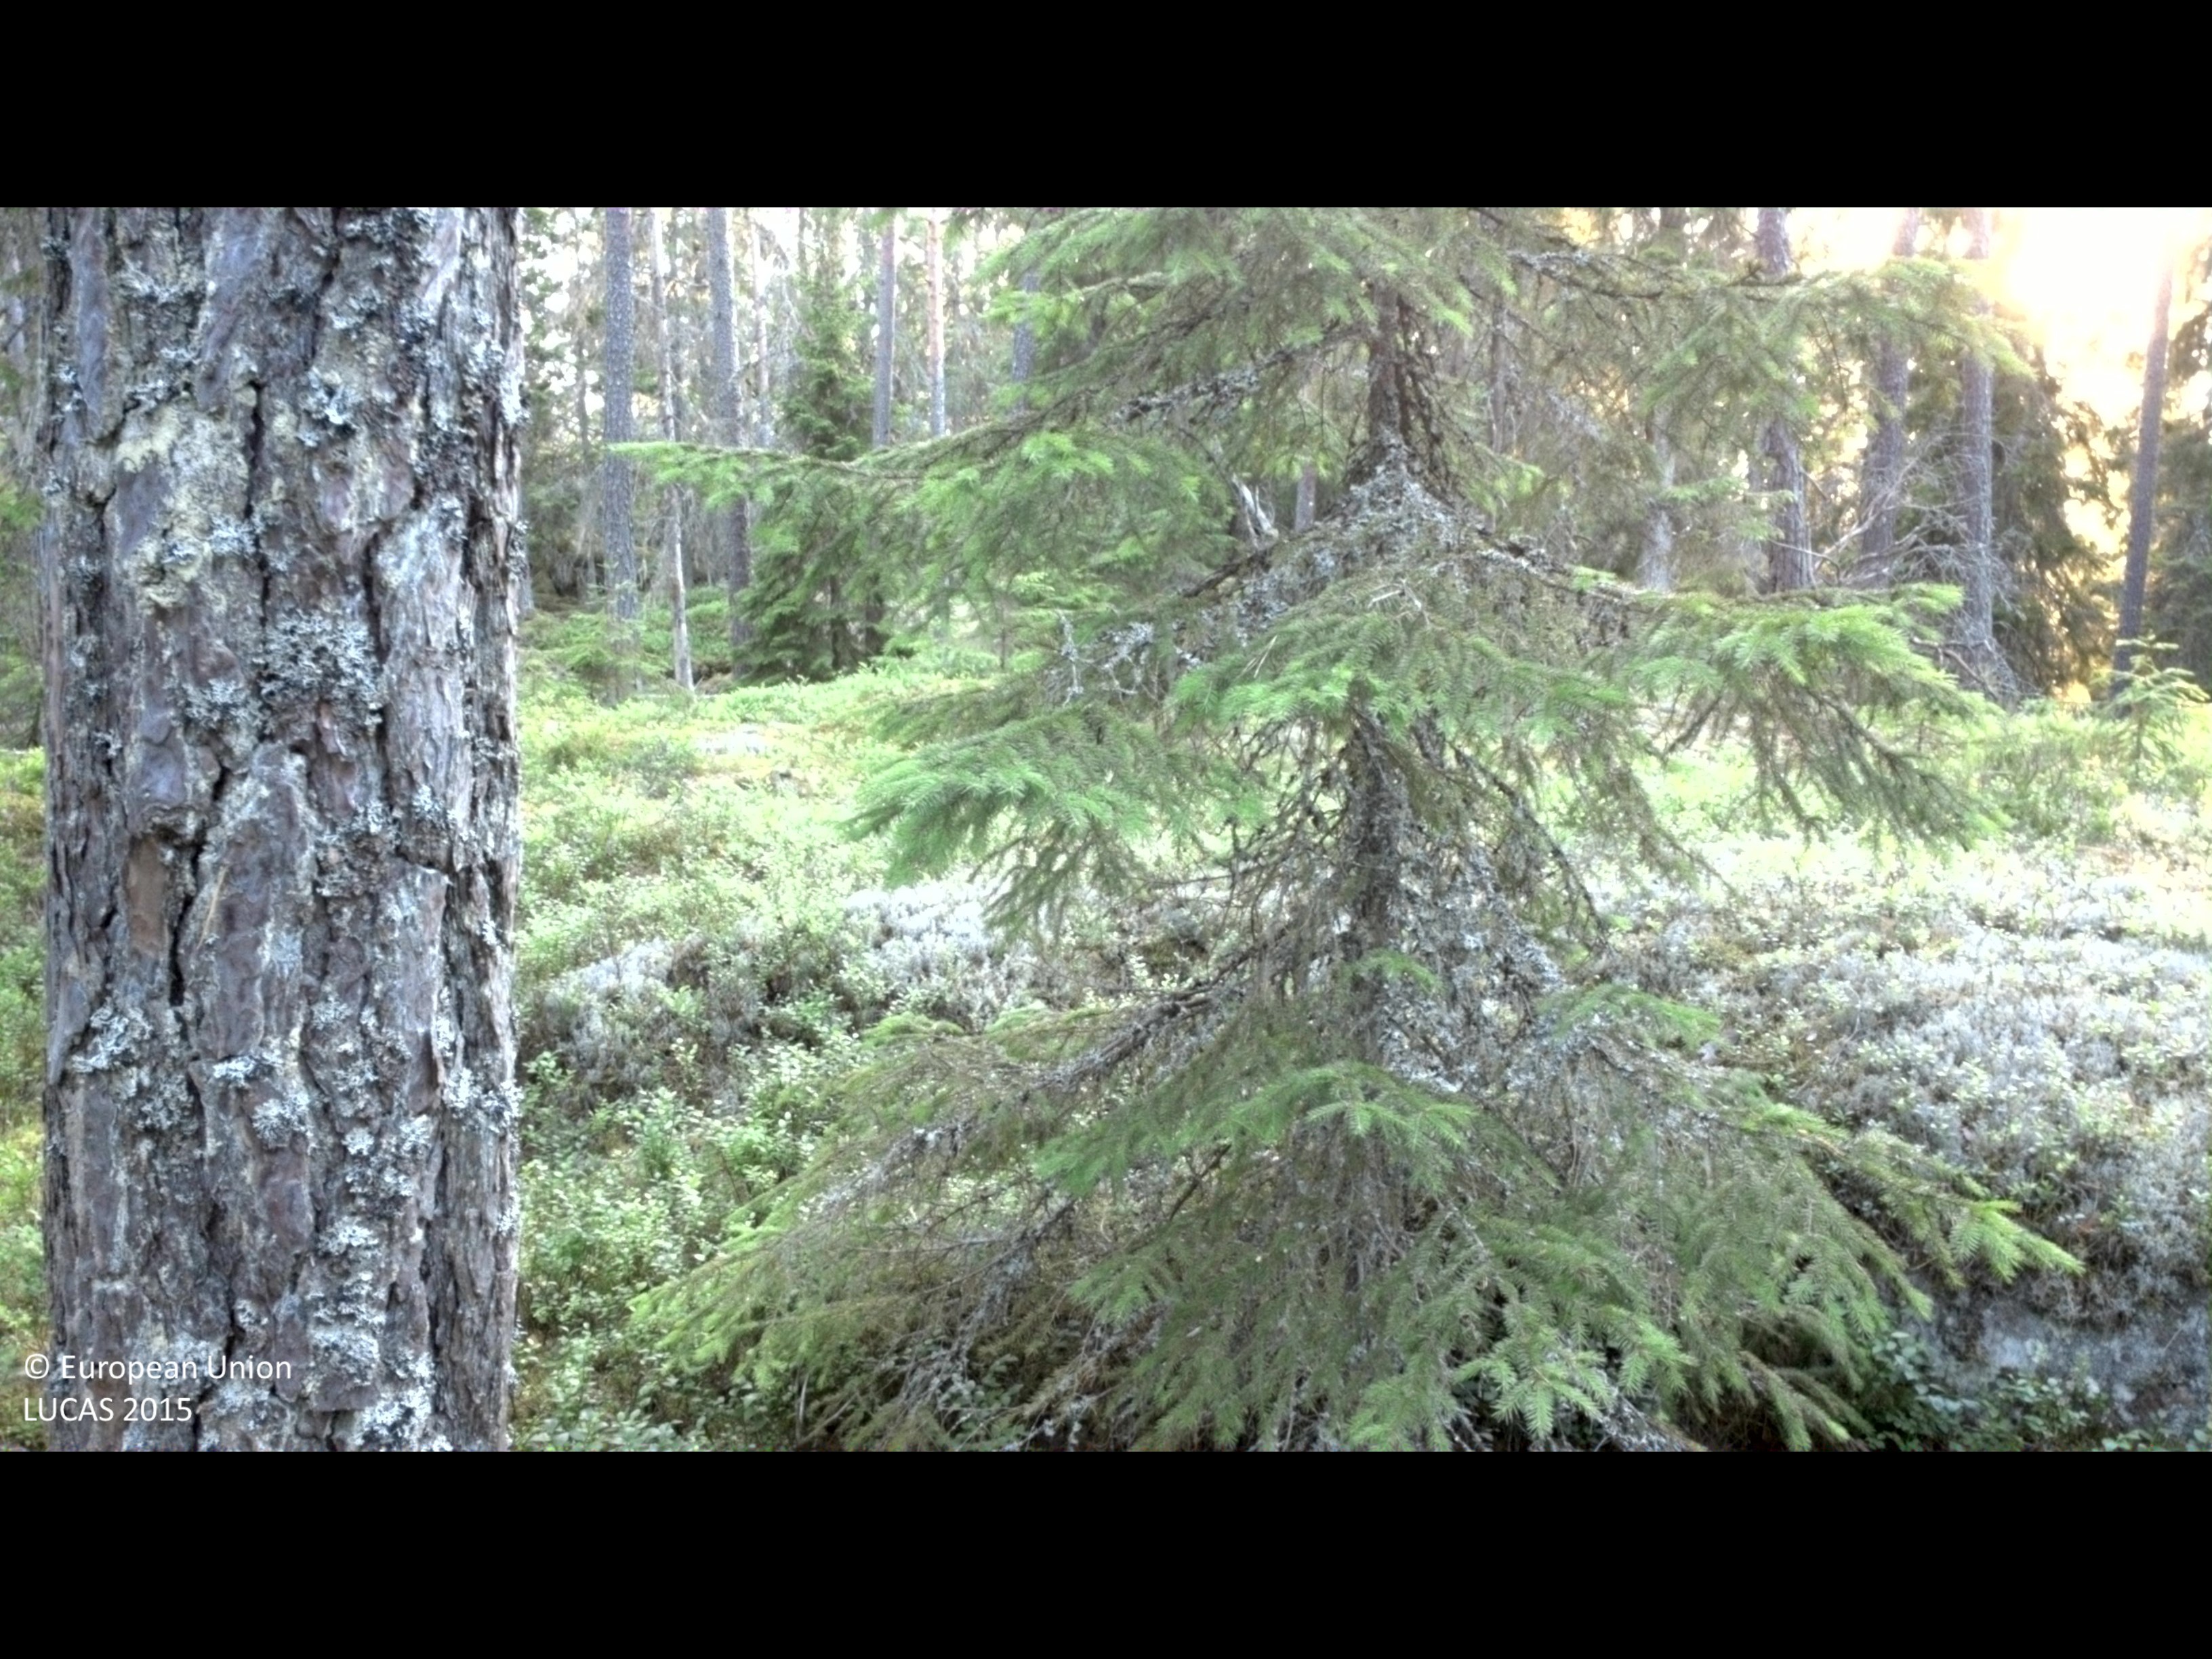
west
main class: Woodland
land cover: Pine dominated coniferous woodland
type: boreal forest
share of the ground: 50 - 75 %
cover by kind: coniferous forest trees 65 %, shrubs 30 %, lichens and mosses 5 %
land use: Amenities, museums, leisure
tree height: > 5 m
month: June
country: SE
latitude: 58.2204
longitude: 16.2100
